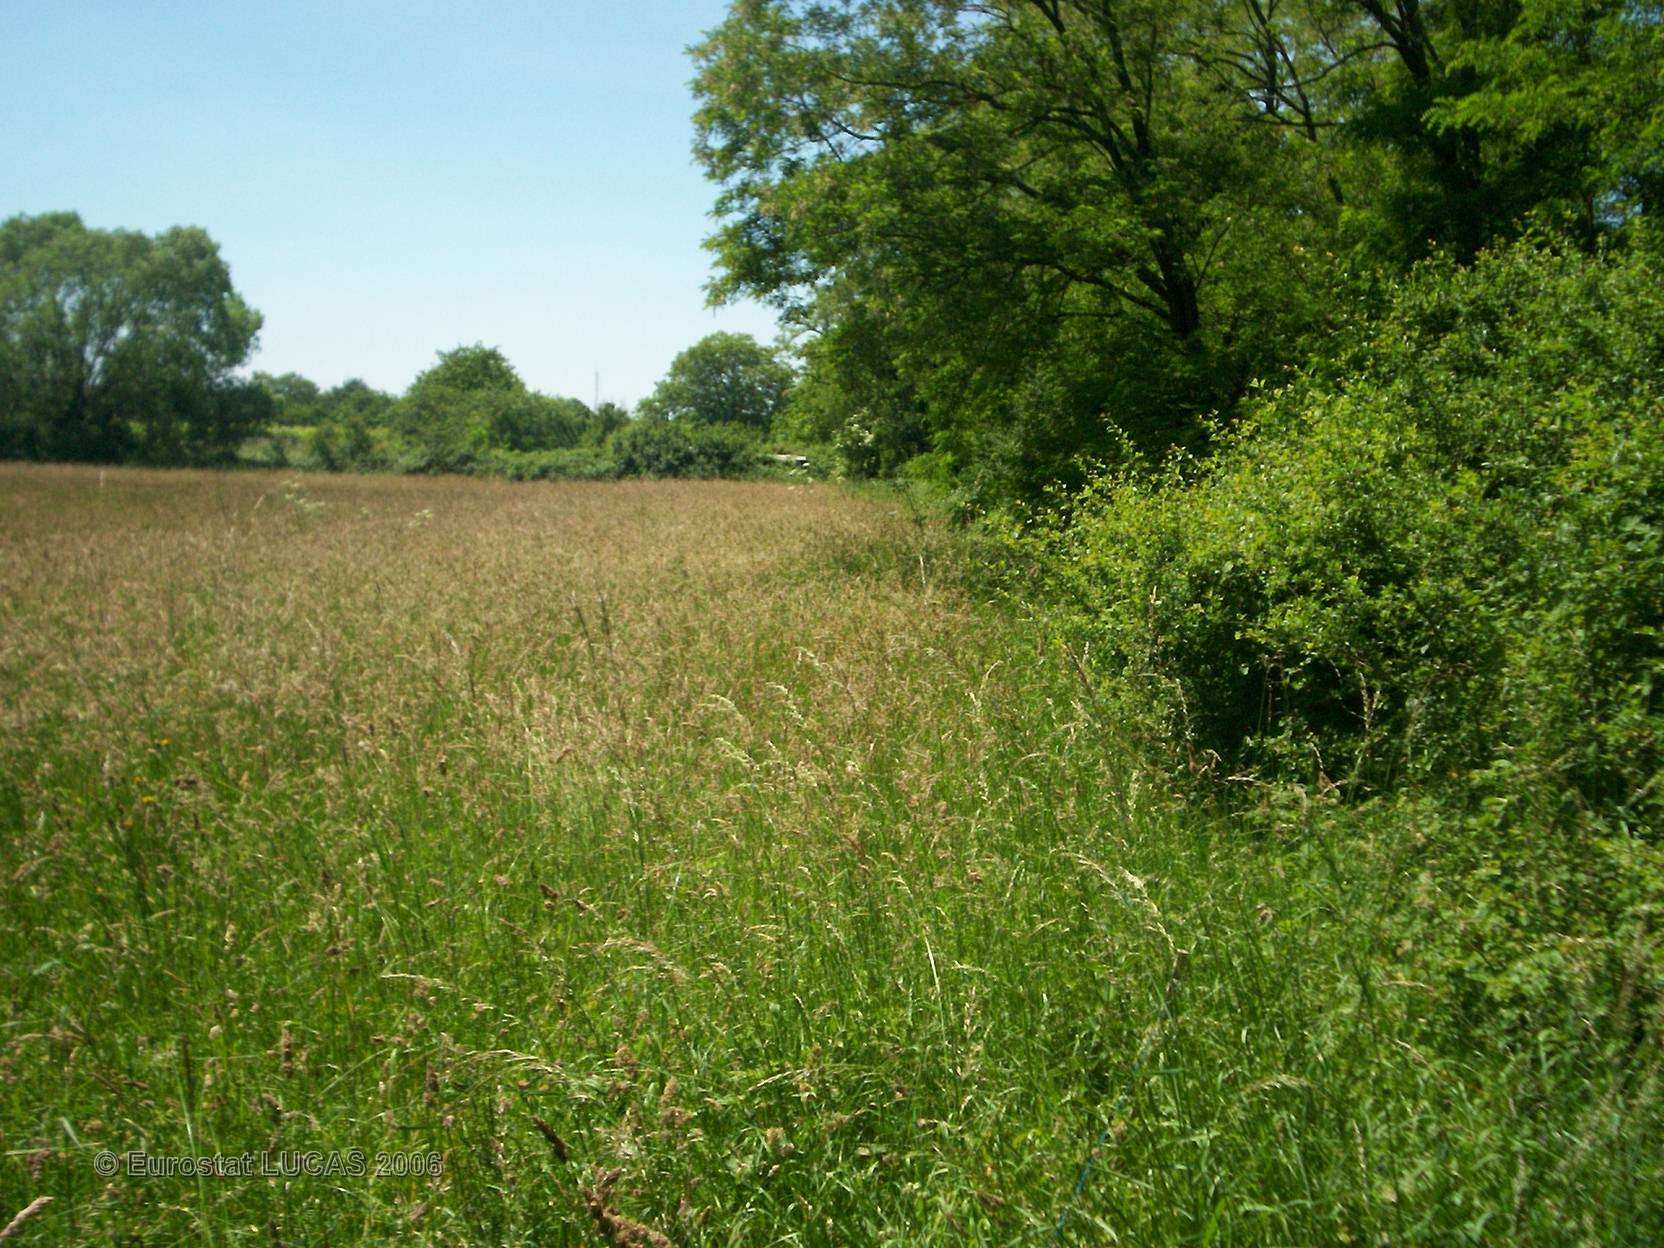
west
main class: Grassland
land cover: Grassland without tree/shrub cover
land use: Agriculture (excluding fallow land and kitchen gardens)
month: June
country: FR
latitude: 47.0115
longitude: 3.0638
